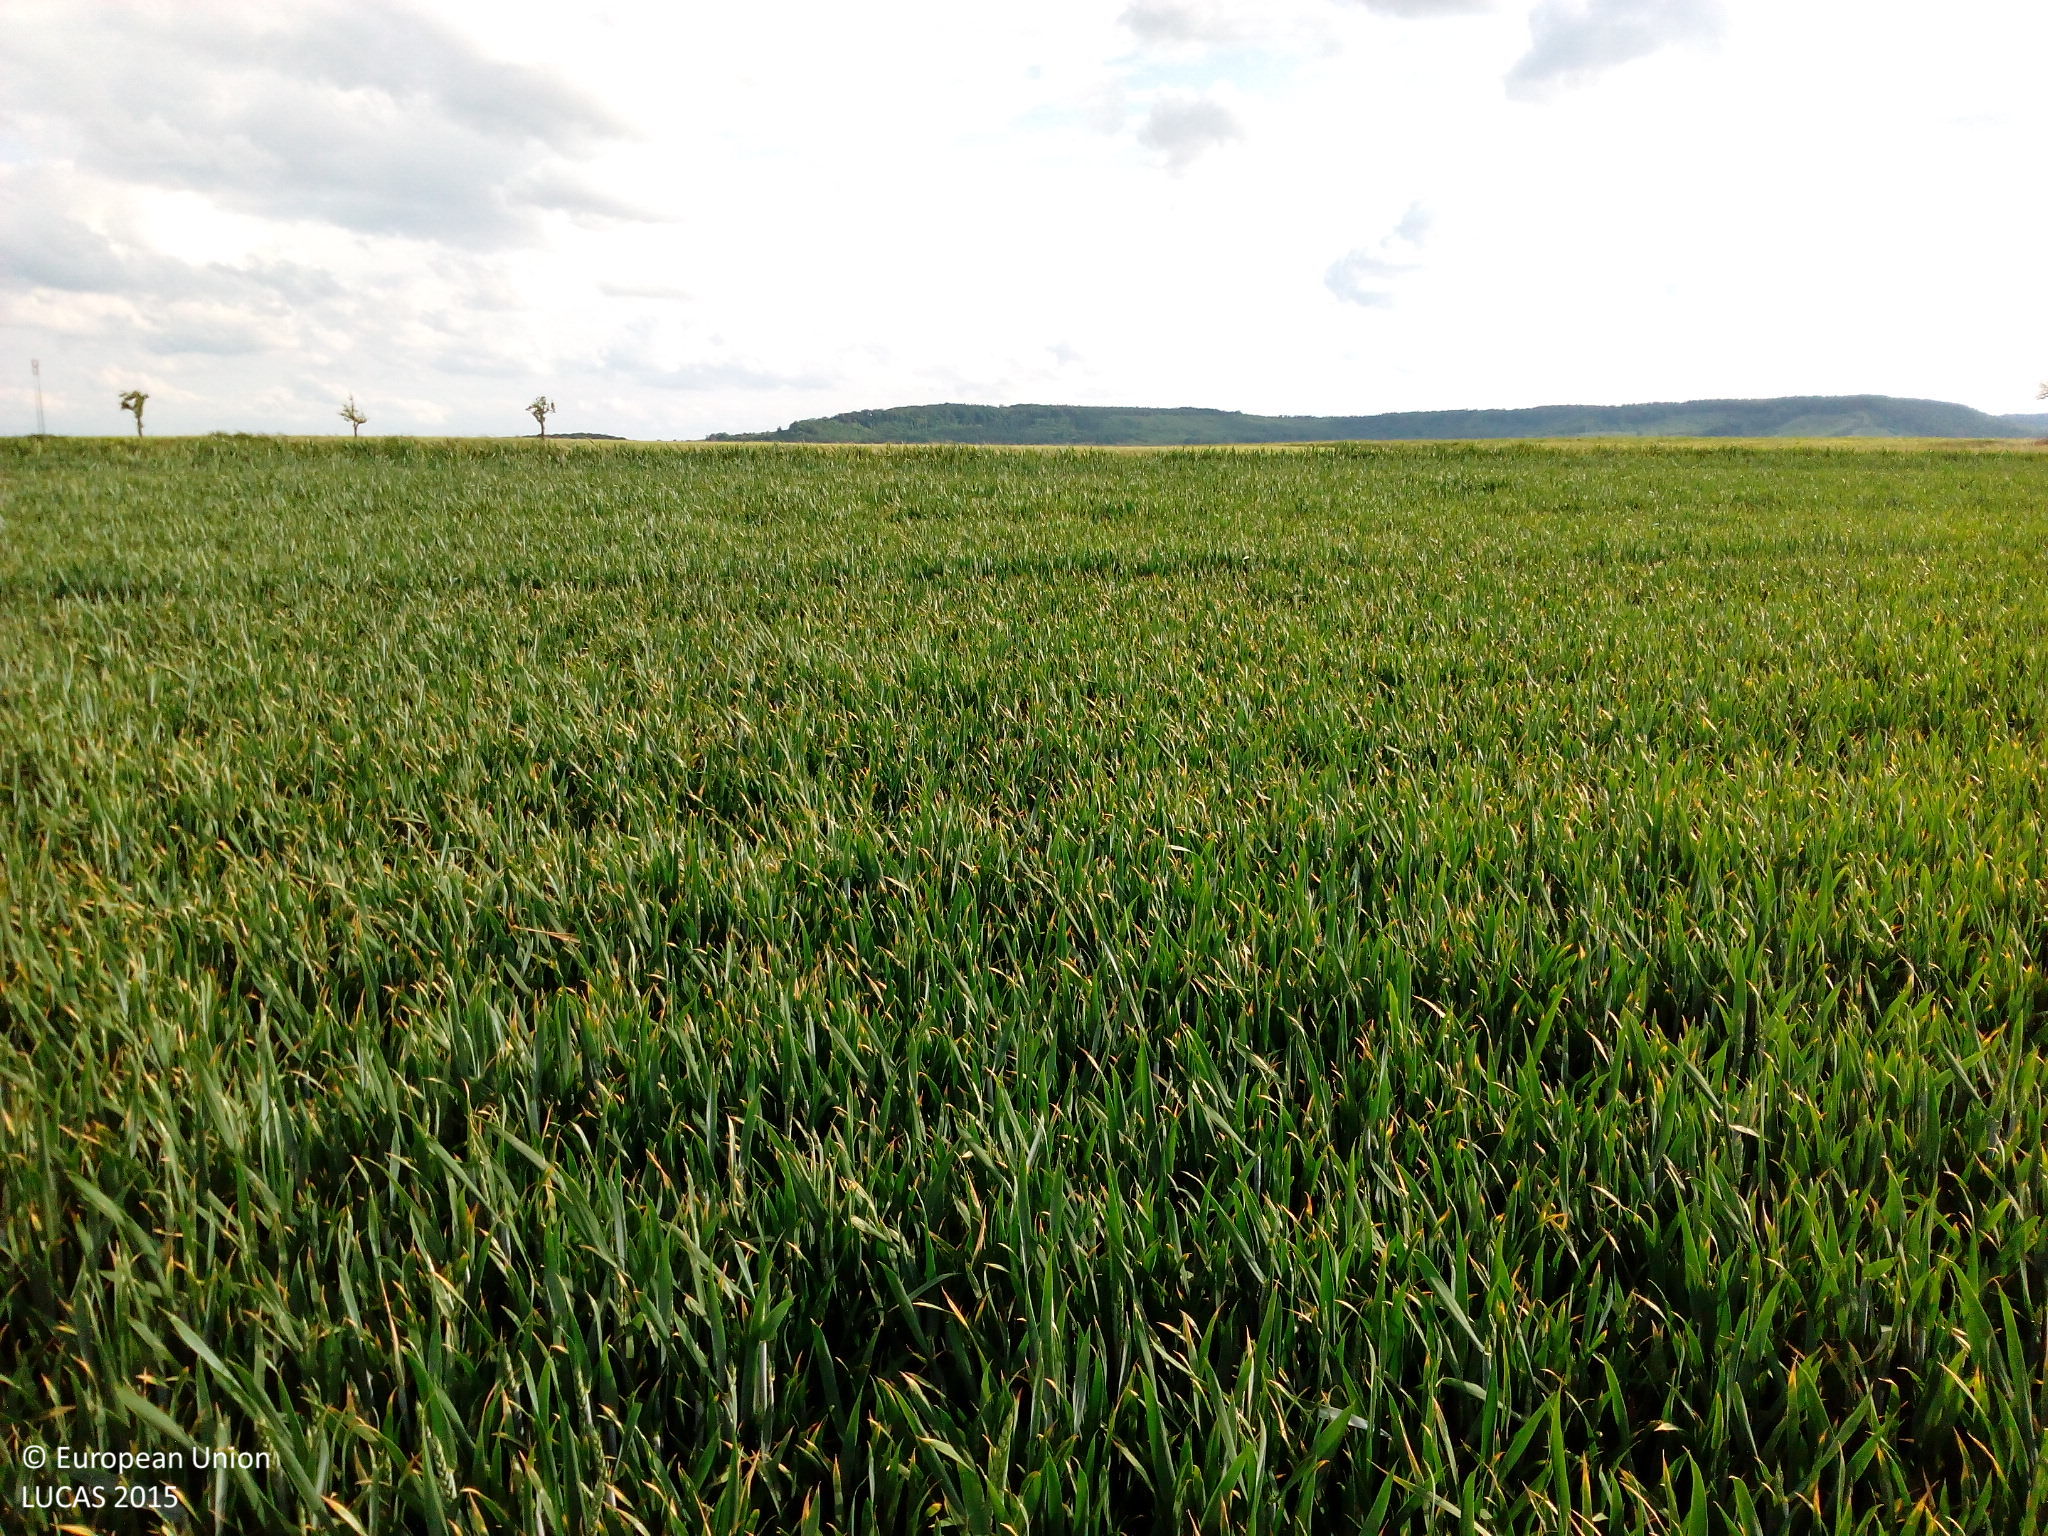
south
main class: Cropland
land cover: Common wheat
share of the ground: > 75 %
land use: Agriculture (excluding fallow land and kitchen gardens)
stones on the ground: < 10 %
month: May
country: DE
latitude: 49.2295
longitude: 9.4098
